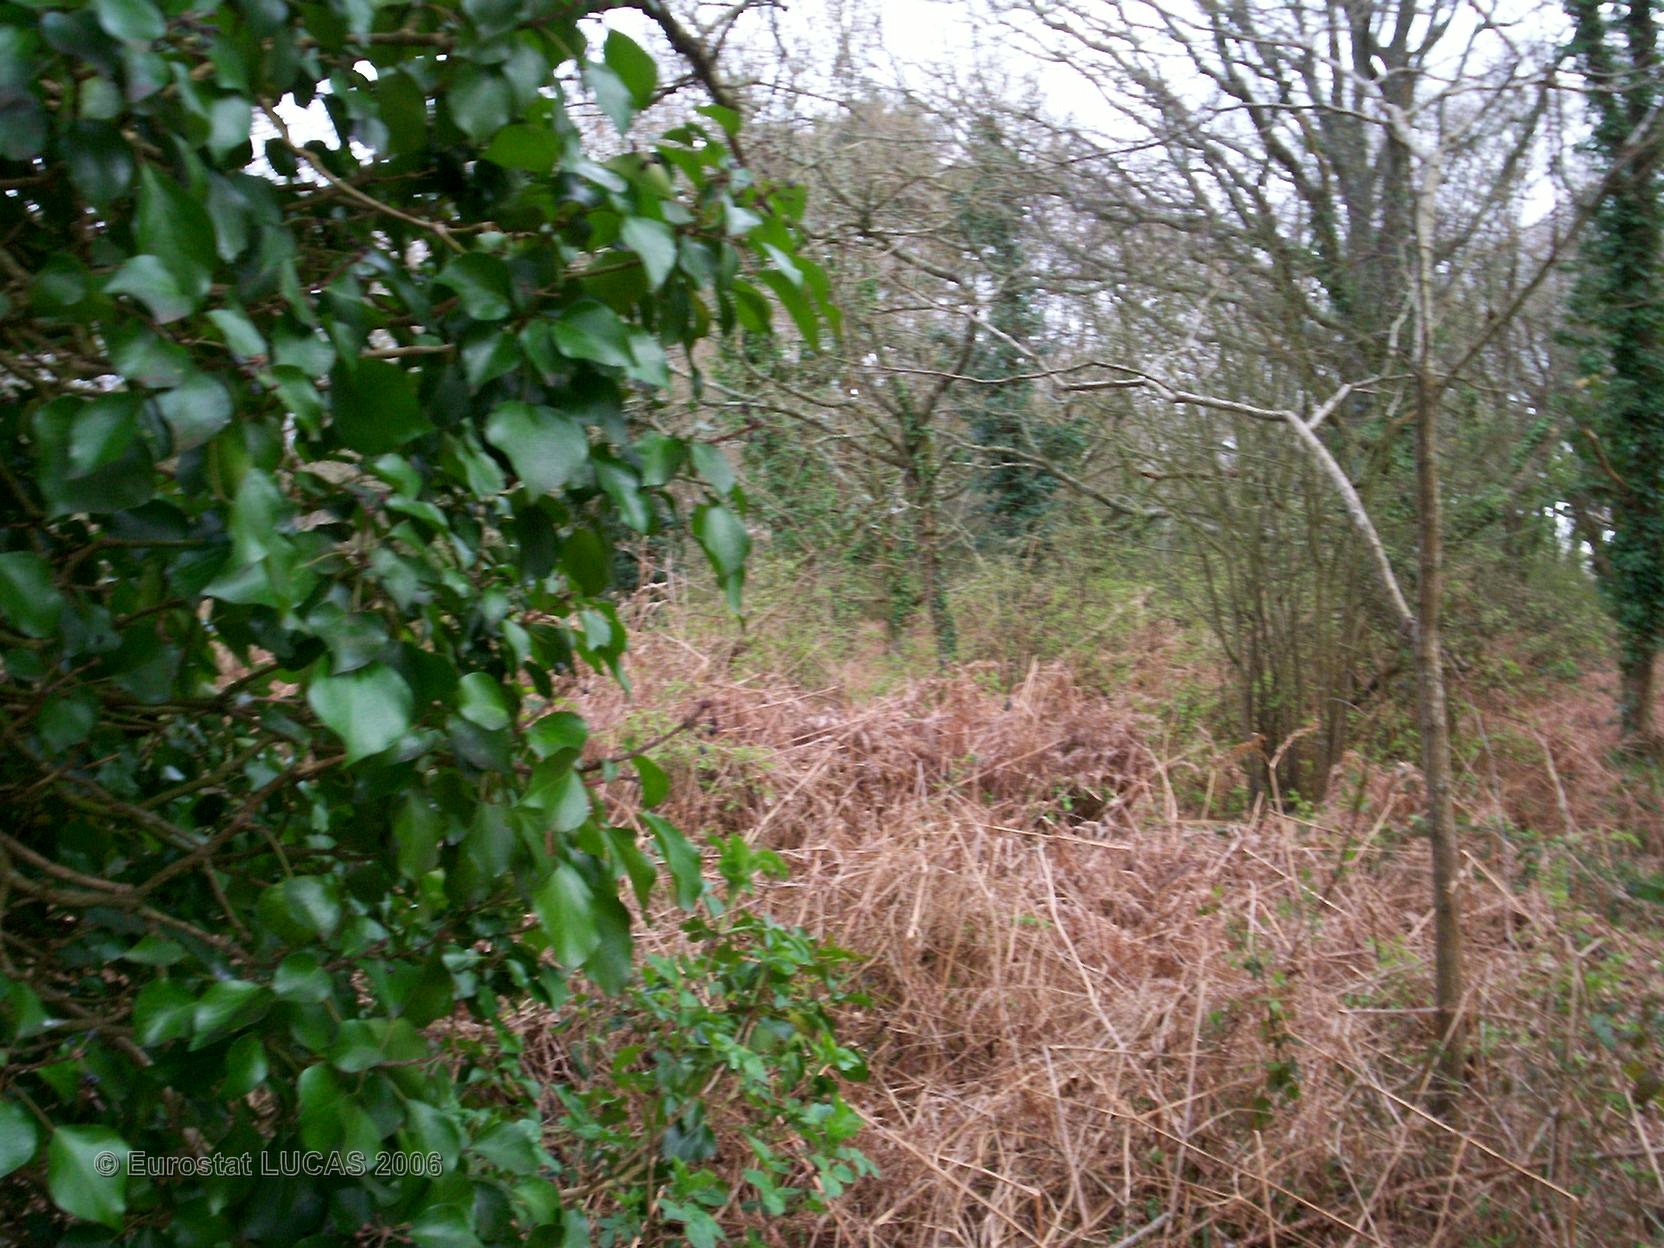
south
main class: Woodland
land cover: Broadleaved forest
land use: Forestry
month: April
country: FR
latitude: 47.7942
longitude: -3.4646
